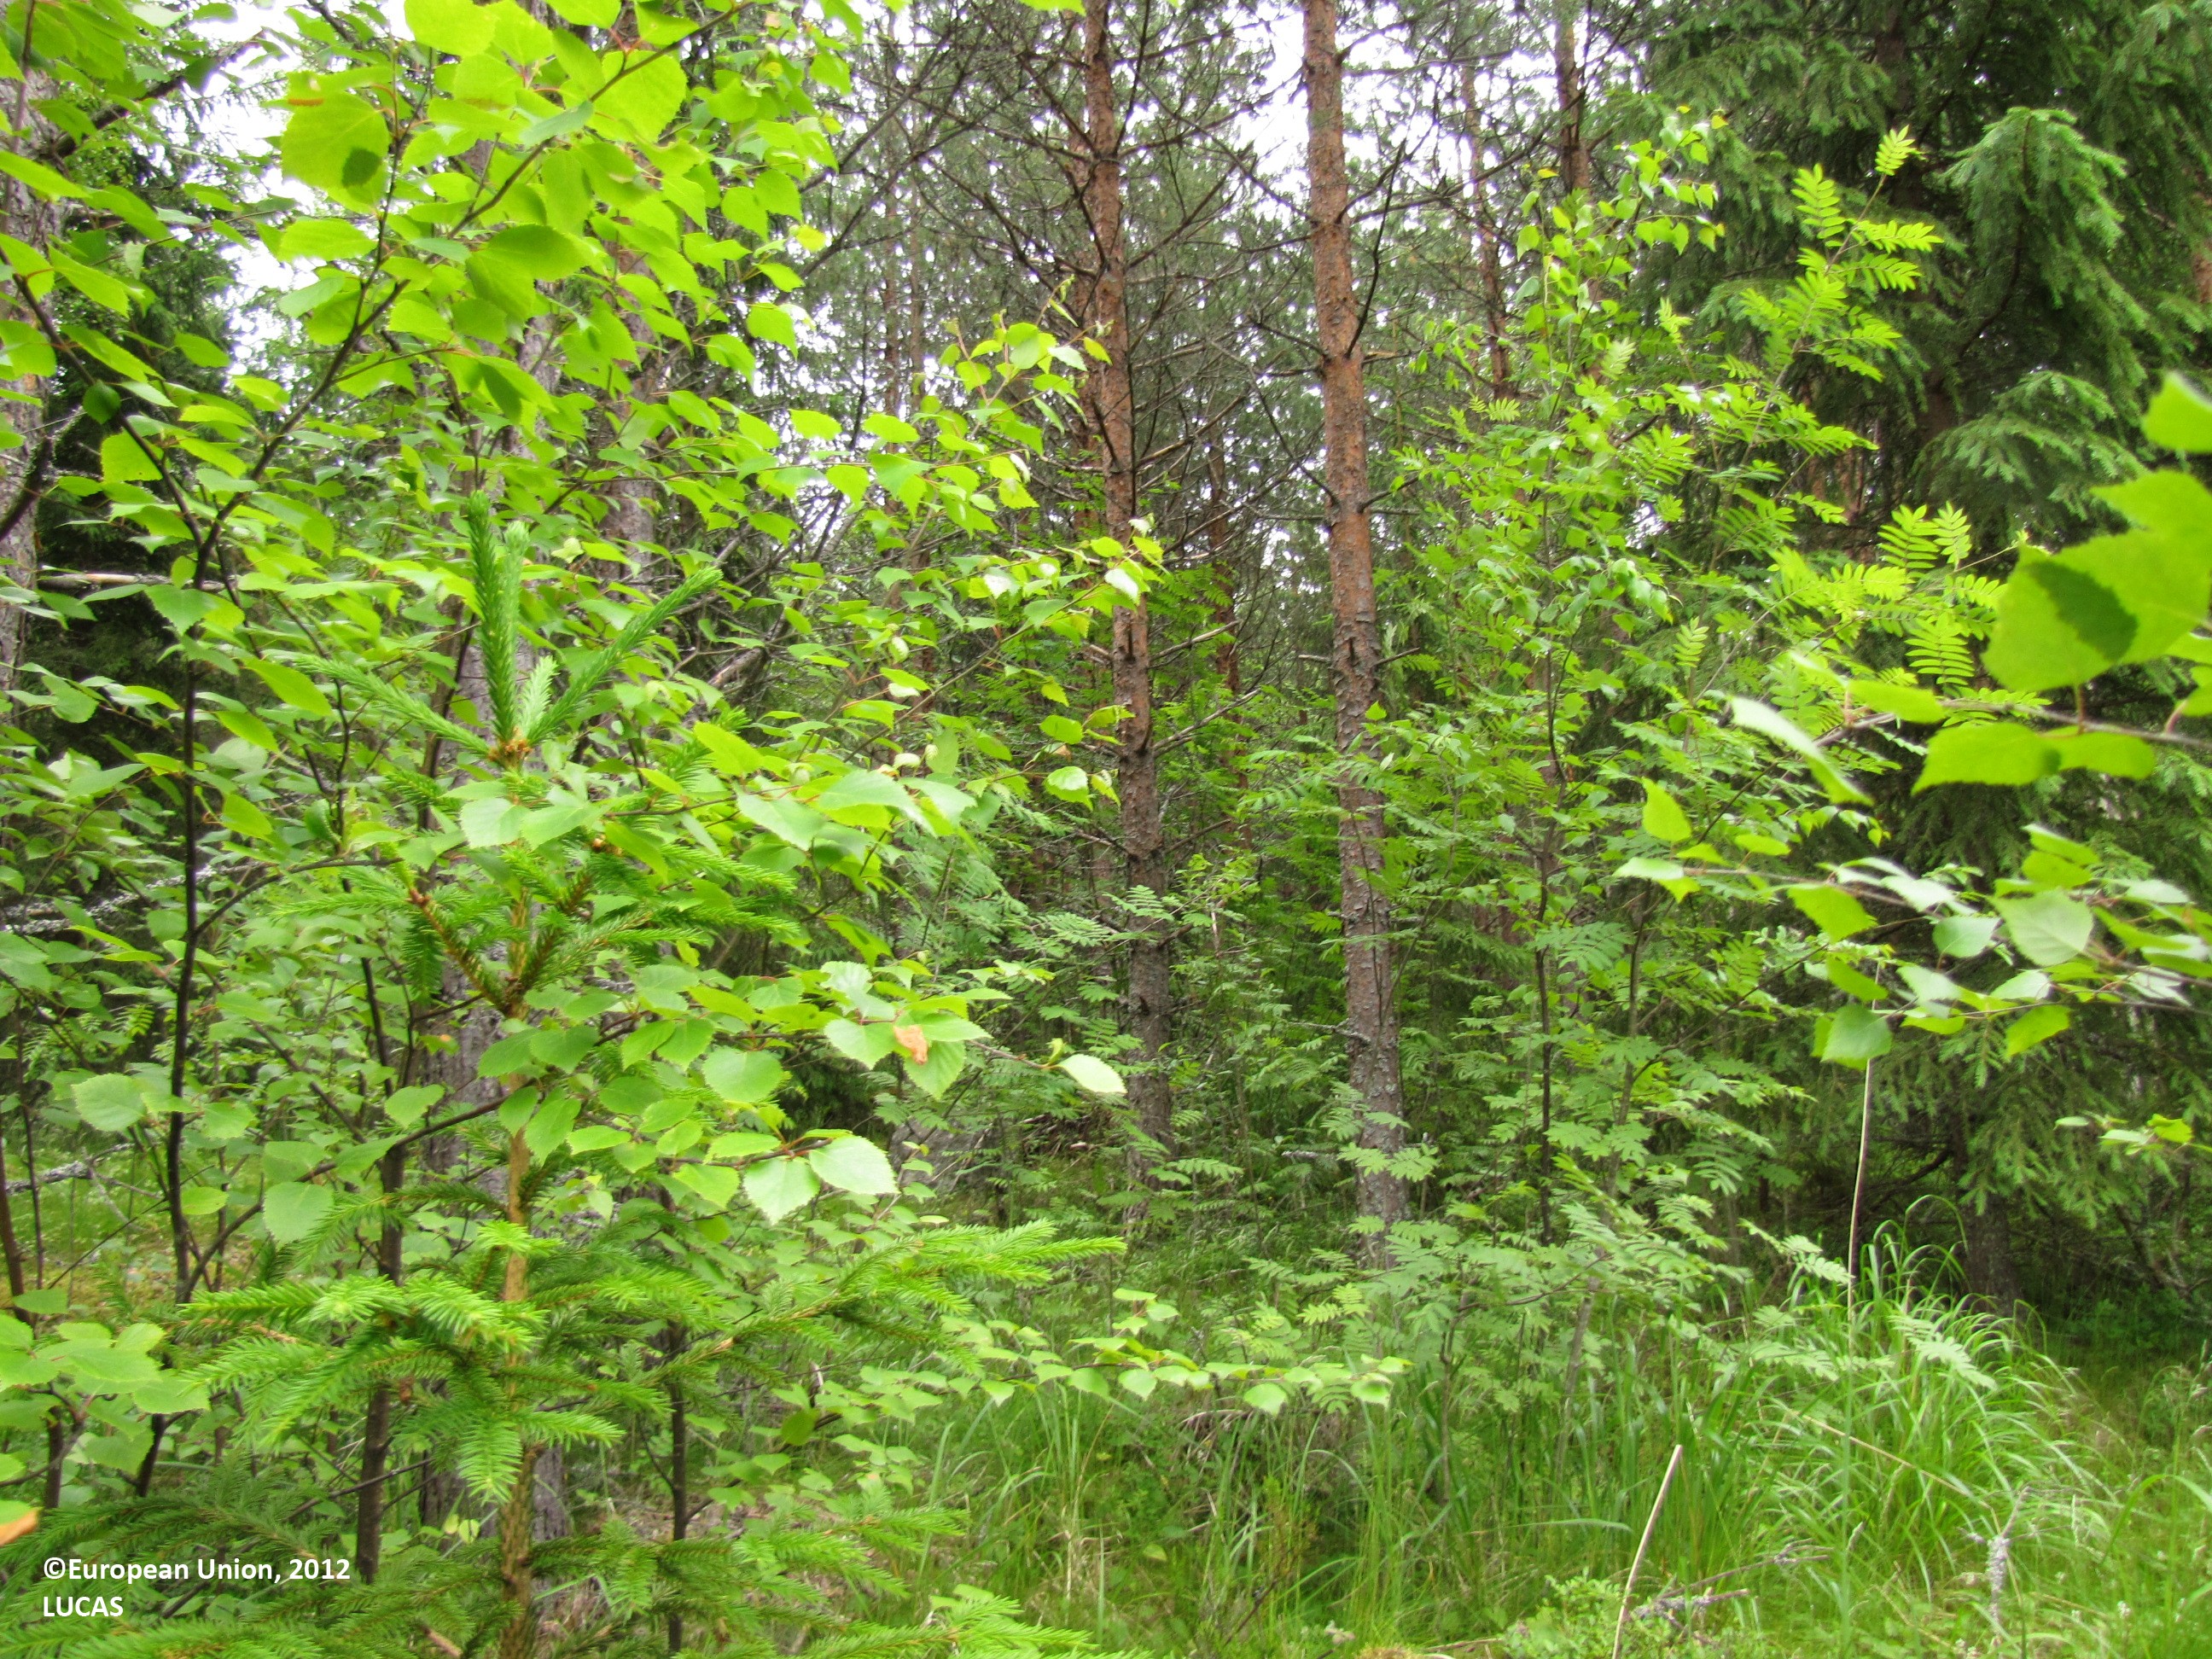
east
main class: Woodland
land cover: Pine dominated mixed woodland
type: boreal forest
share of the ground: 25 - 50 %
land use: Forestry
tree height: > 5 m
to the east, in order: Pine dominated mixed woodland; Spruce dominated mixed woodland; Pine dominated coniferous woodland; Spruce dominated coniferous woodland
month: June
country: FI
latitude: 61.8058
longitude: 24.5740
